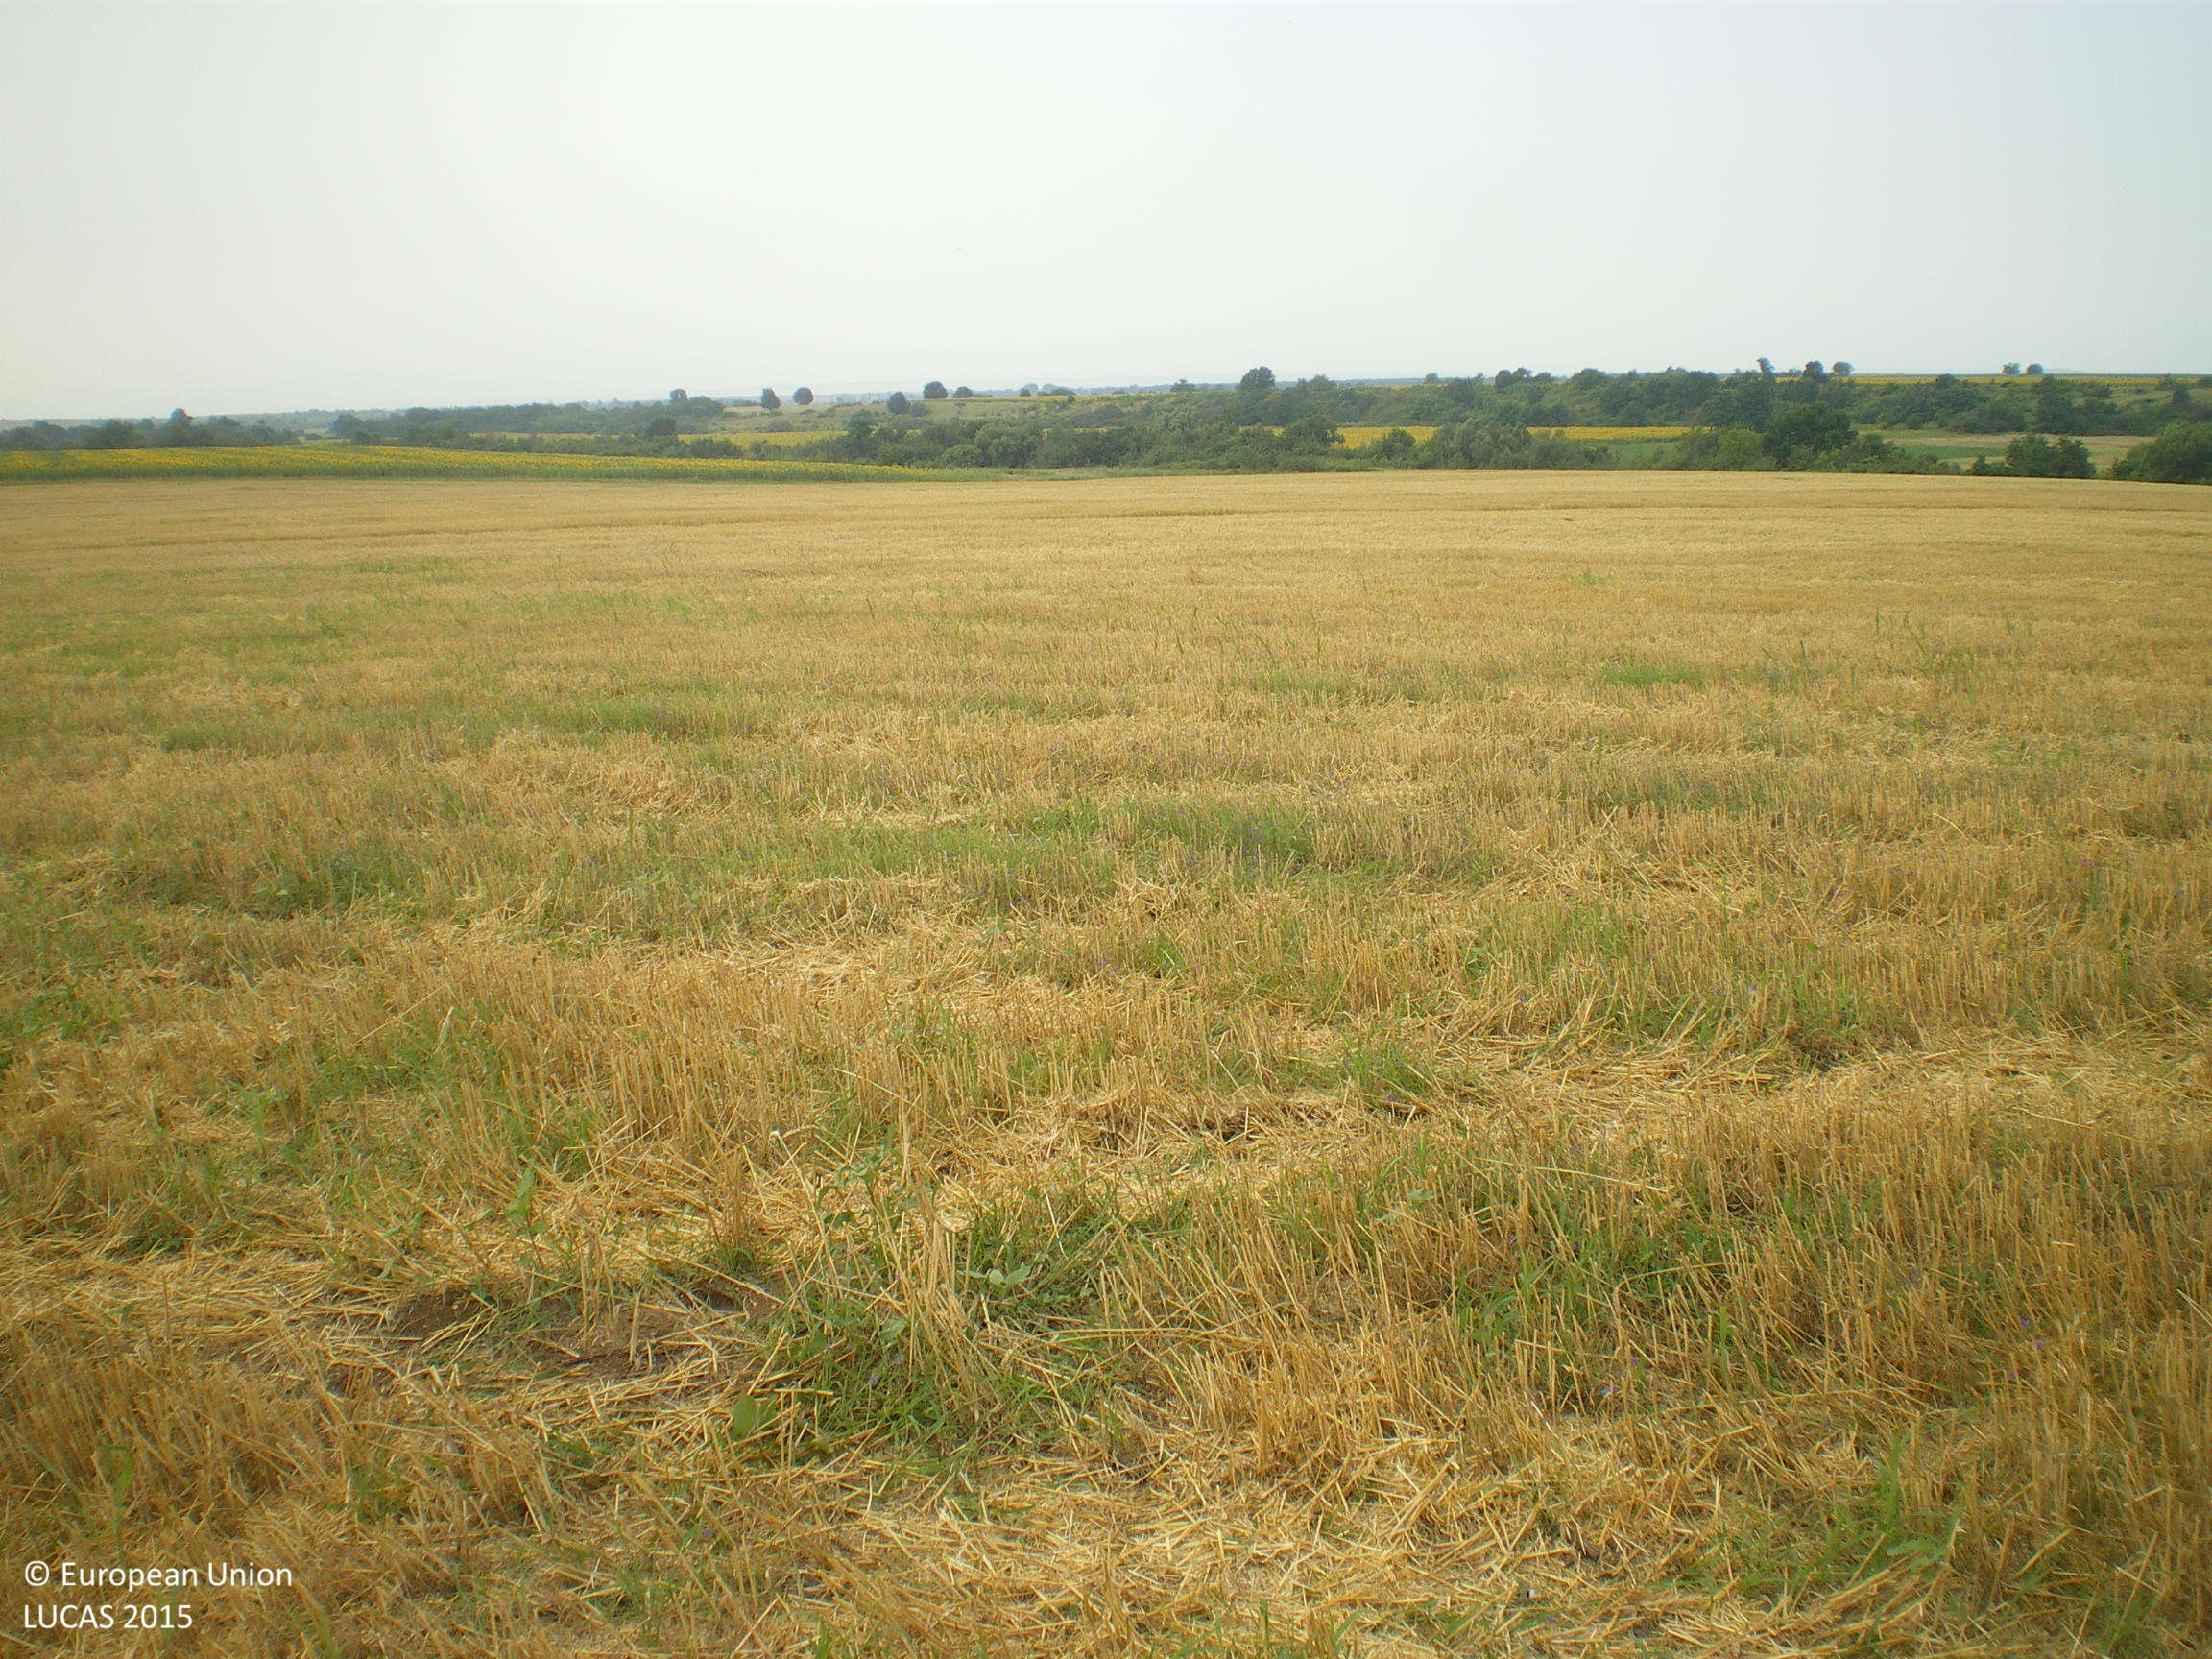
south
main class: Cropland
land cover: Common wheat
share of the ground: 25 - 50 %
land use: Agriculture (excluding fallow land and kitchen gardens)
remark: Harvested field
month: July
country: BG
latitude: 42.3187
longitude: 25.1181
